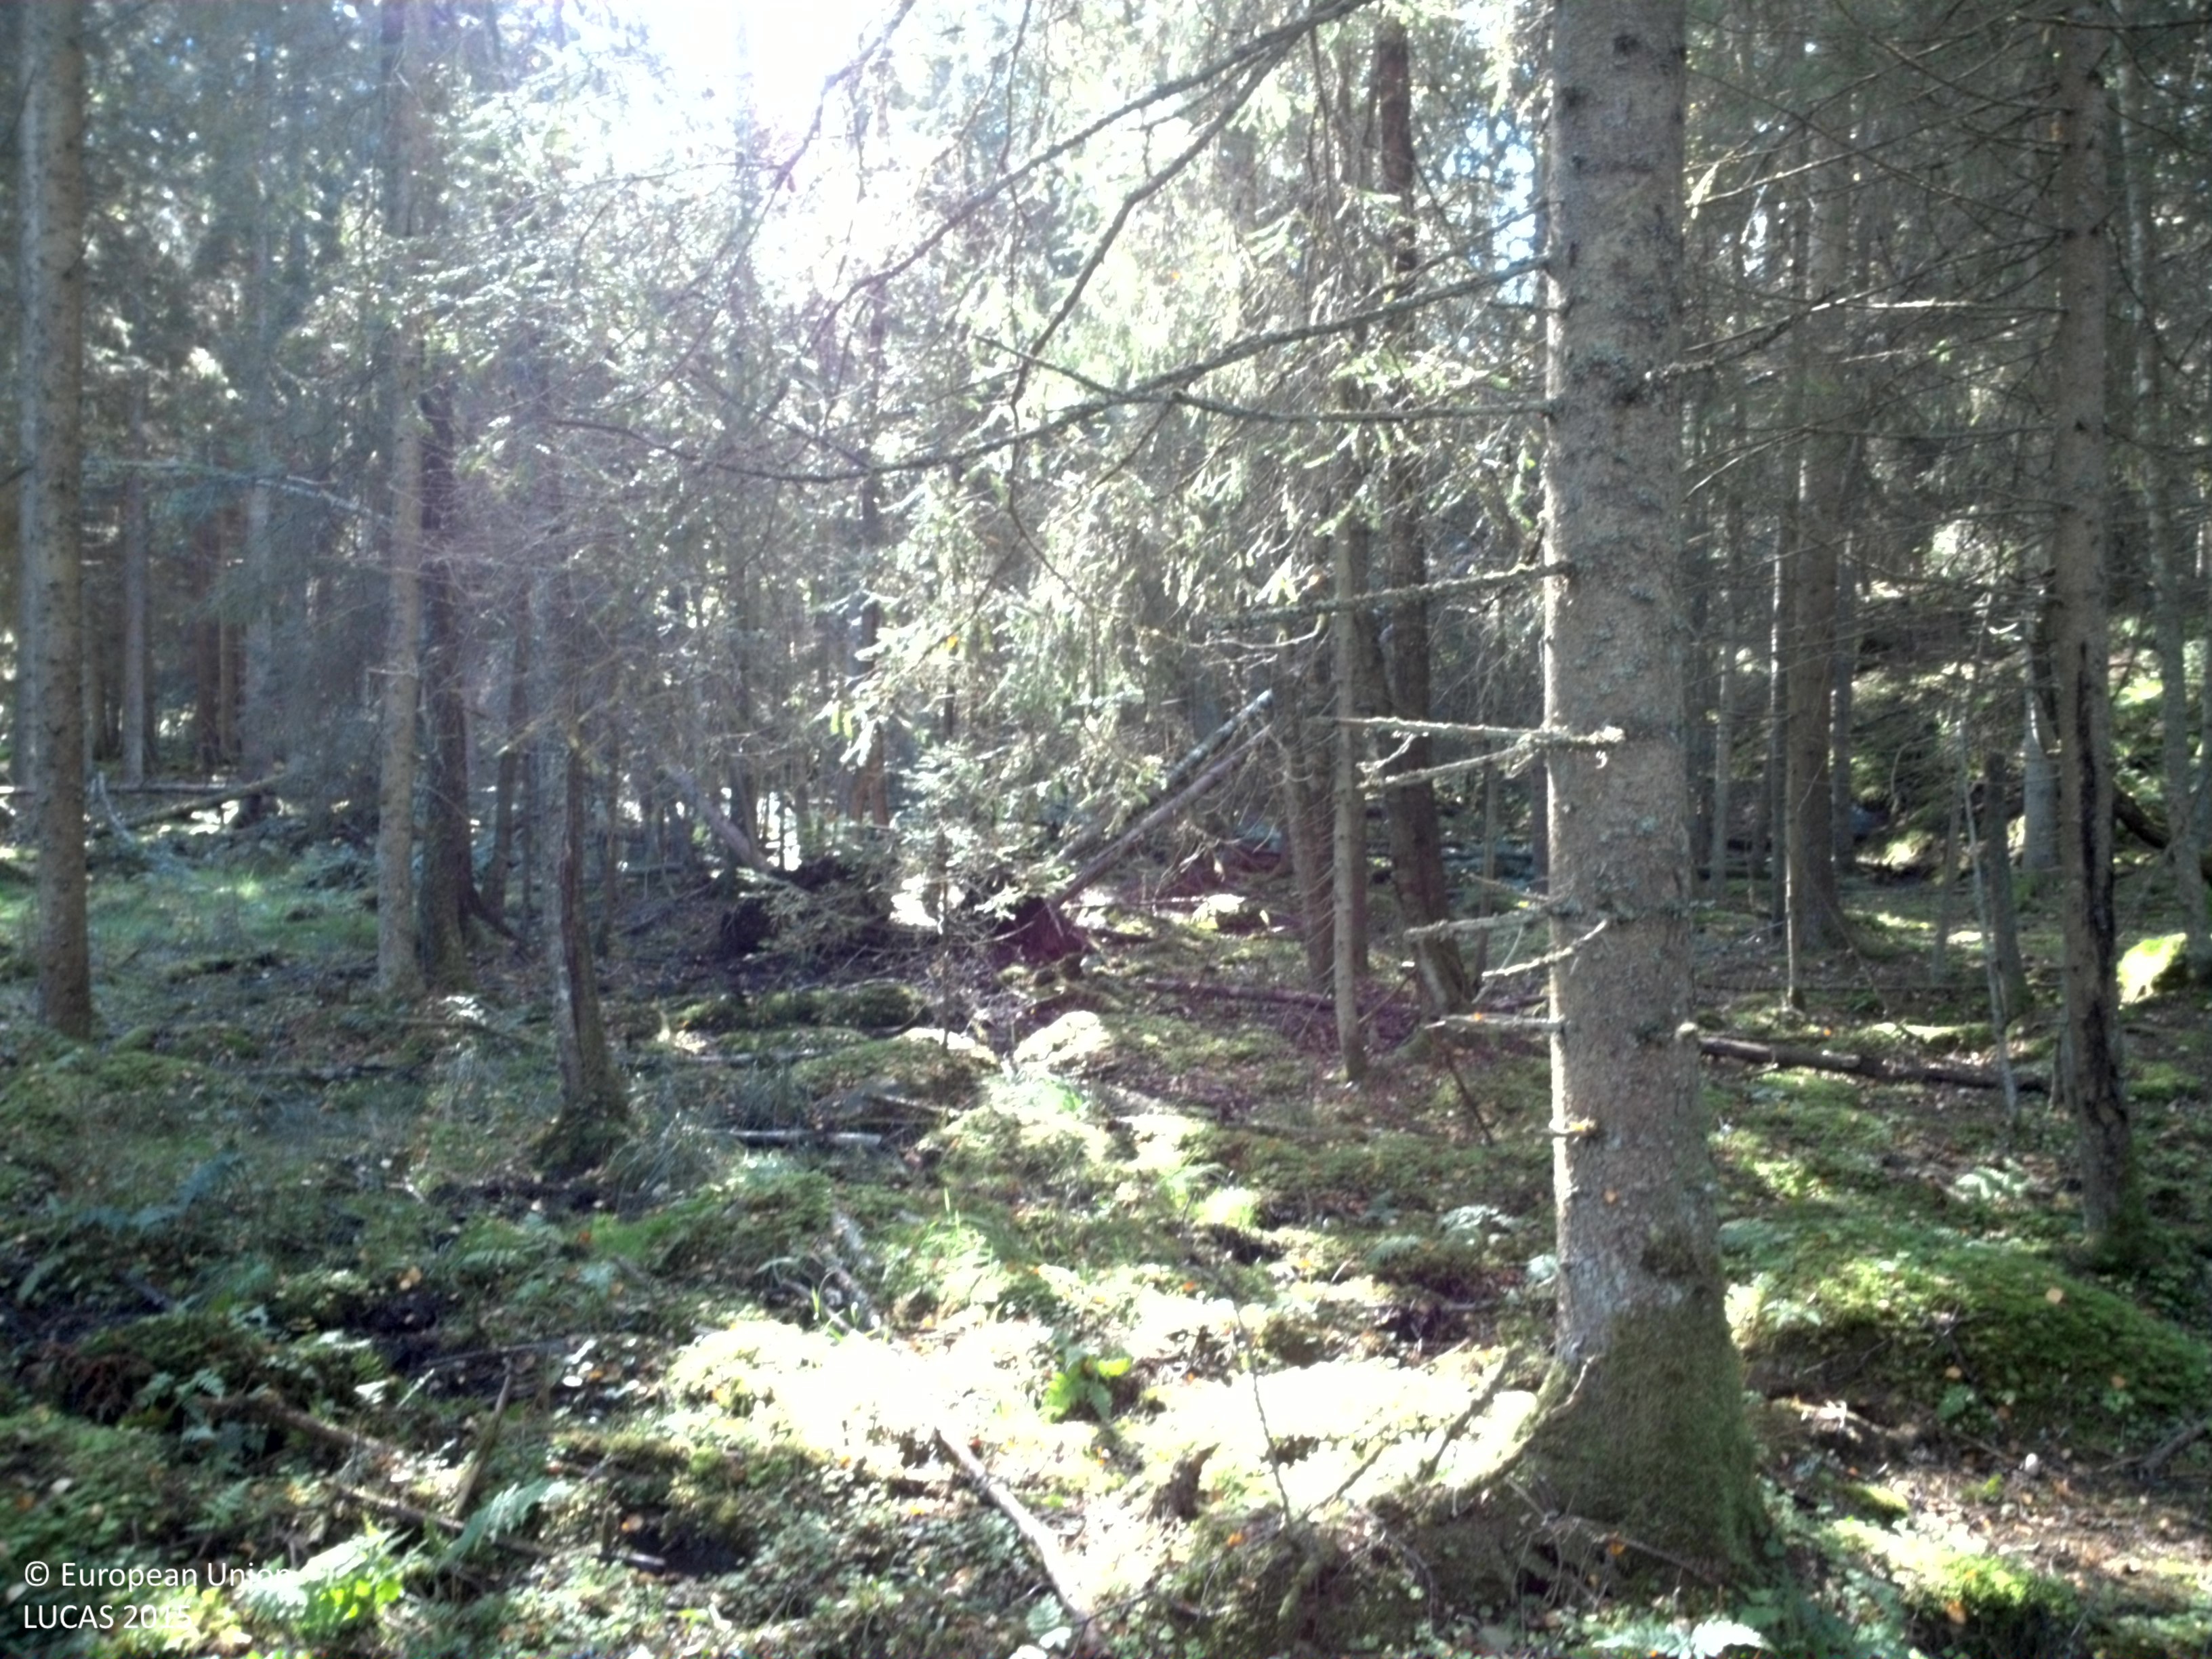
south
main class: Woodland
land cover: Spruce dominated mixed woodland
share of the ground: 50 - 75 %
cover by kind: coniferous forest trees 40 %, lichens and mosses 30 %, broadleaved forest trees 25 %, herbaceous plants 5 %
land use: Forestry
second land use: Agriculture (excluding fallow land and kitchen gardens)
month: September
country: SE
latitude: 57.9461
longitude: 13.2555
